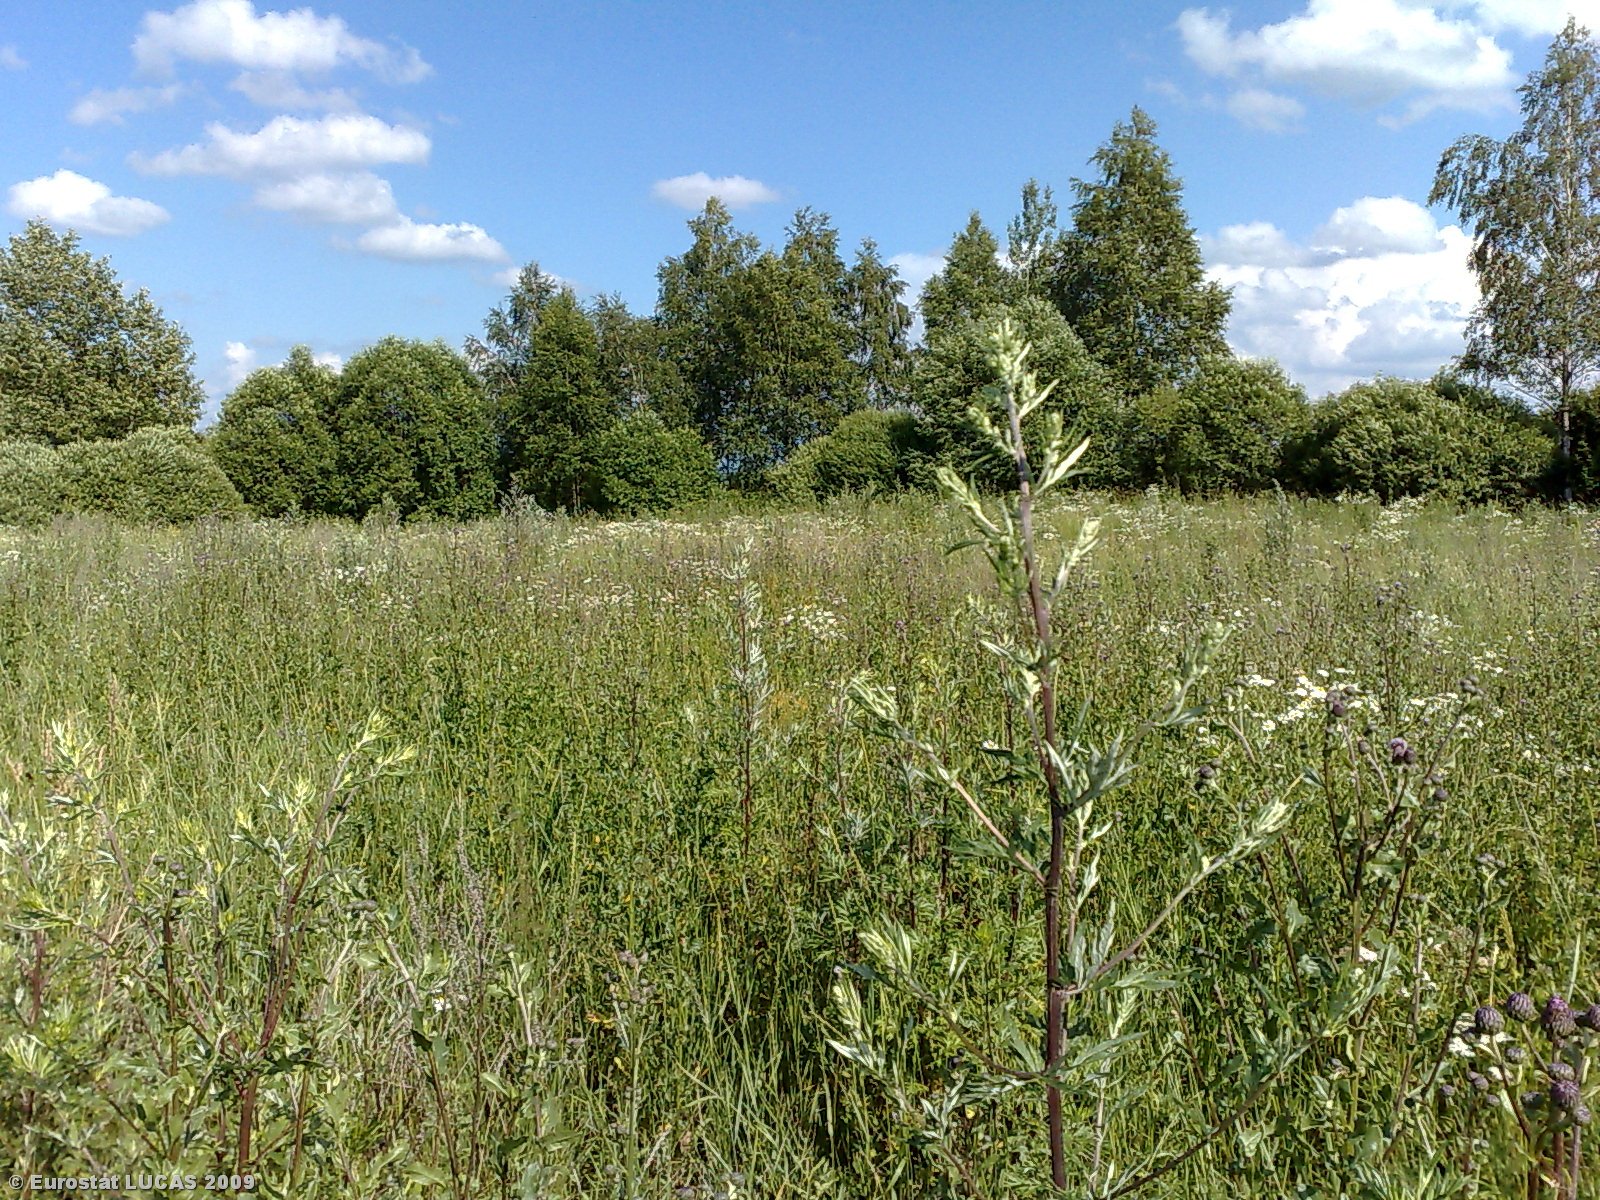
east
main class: Grassland
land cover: Grassland without tree/shrub cover
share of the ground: > 75 %
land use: Agriculture (excluding fallow land and kitchen gardens)
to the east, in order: Grassland without tree/shrub cover; Shrubland with sparse tree cover; Grass margins; Paved roads, cycling and walking lanes; Grassland without tree/shrub cover; Electric lines; Grassland without tree/shrub cover
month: July
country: LT
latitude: 55.5120
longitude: 22.7494
